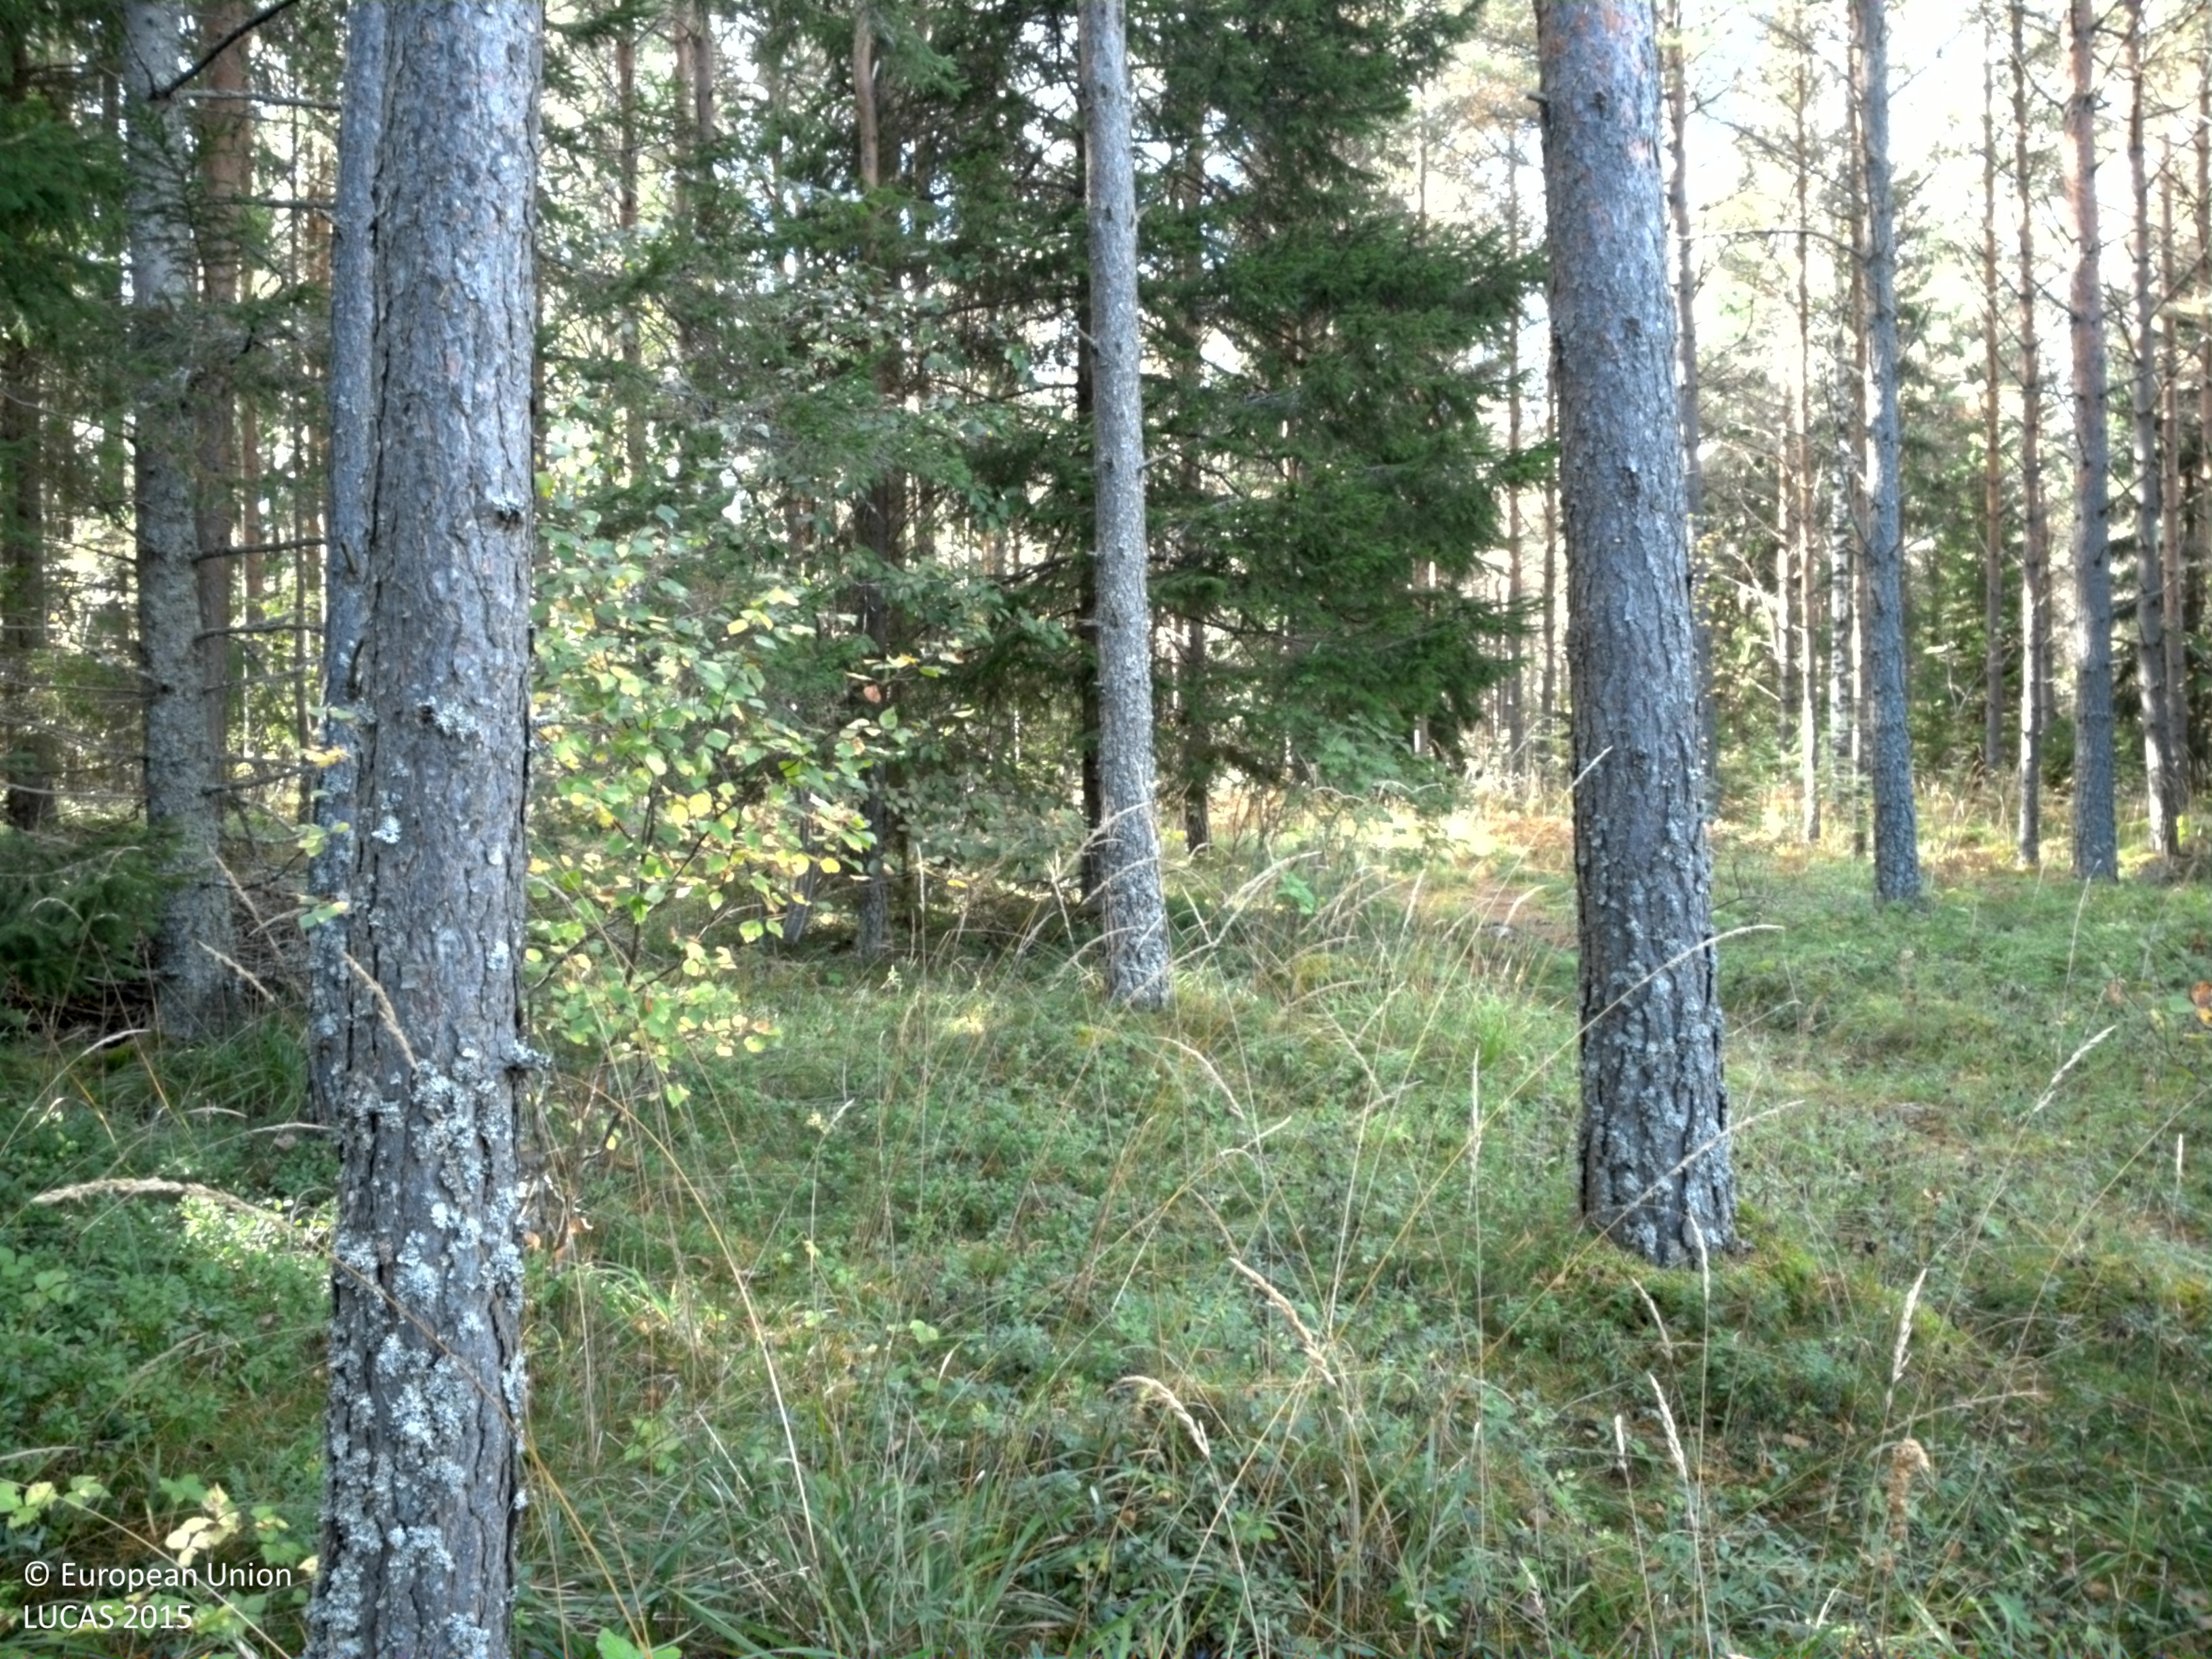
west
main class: Woodland
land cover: Pine dominated coniferous woodland
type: boreal forest
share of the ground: 50 - 75 %
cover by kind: coniferous forest trees 50 %, herbaceous plants 40 %, broadleaved forest trees 10 %
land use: Forestry
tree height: > 5 m
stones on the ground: < 10 %
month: September
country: SE
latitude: 59.8465
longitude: 18.8708
